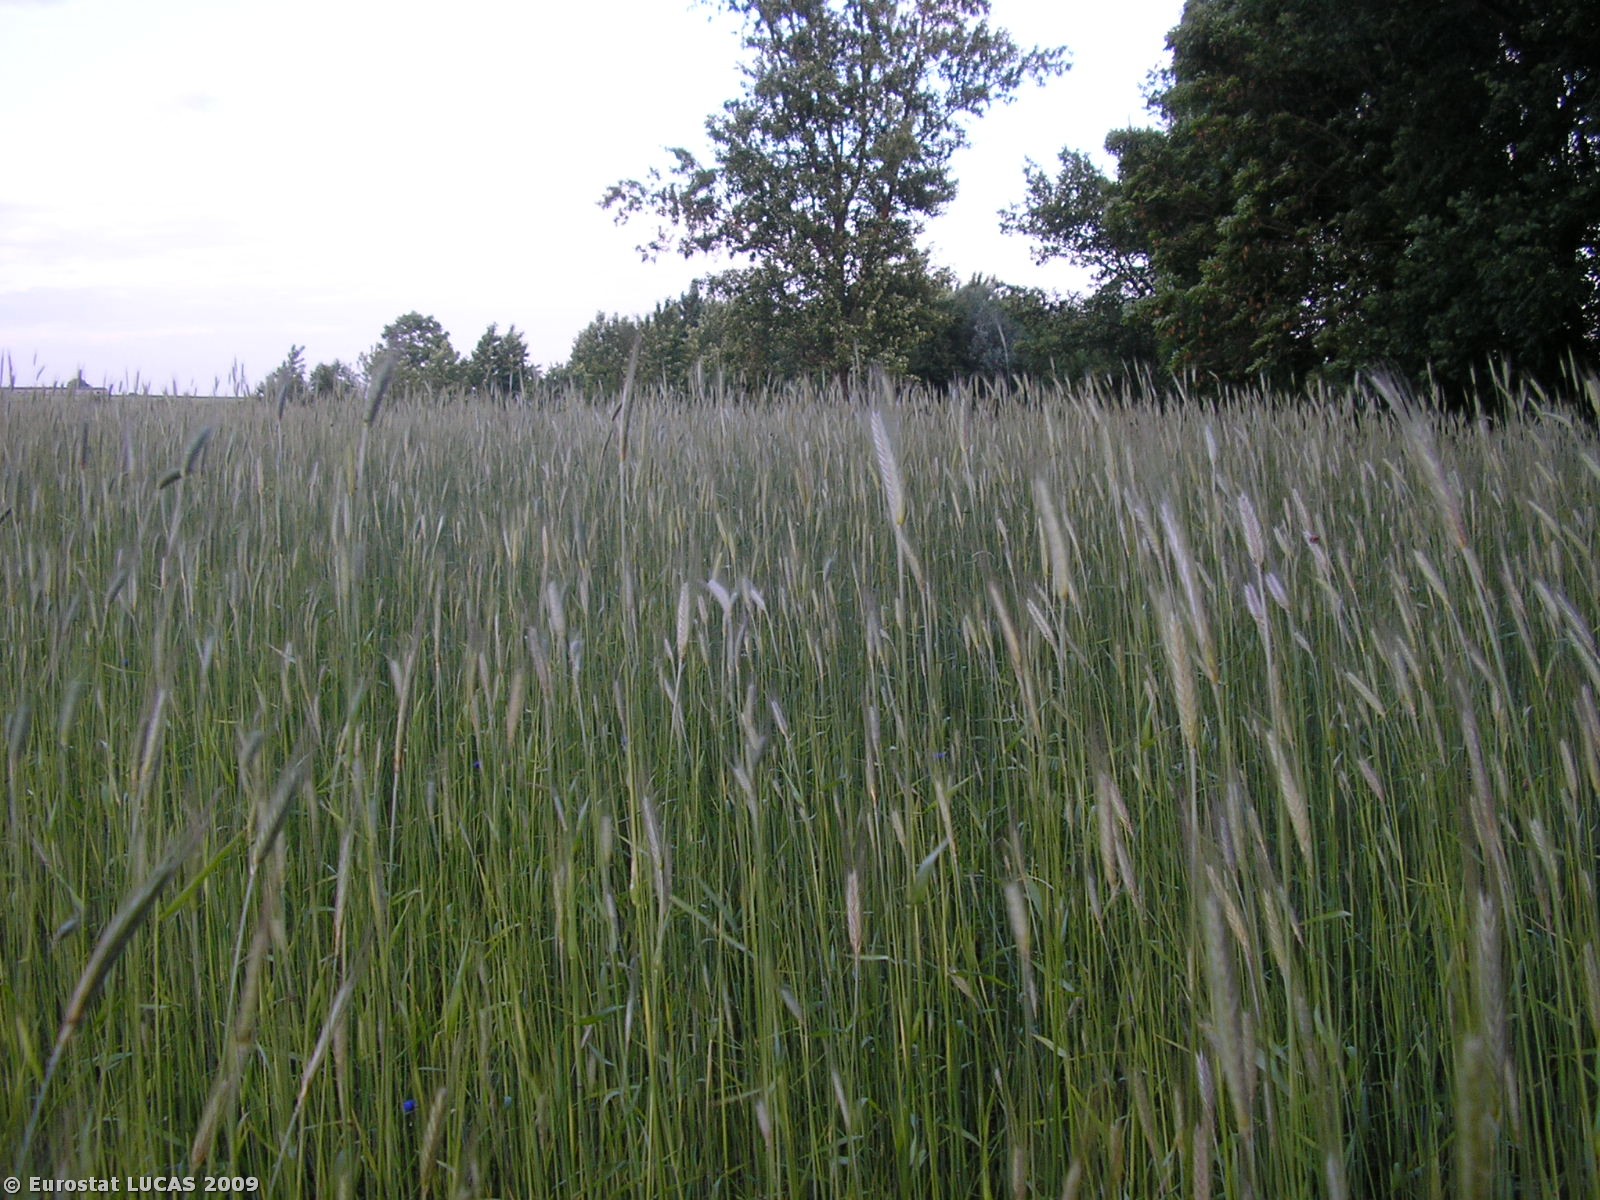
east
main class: Cropland
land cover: Rye
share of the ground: > 75 %
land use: Agriculture (excluding fallow land and kitchen gardens)
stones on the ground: < 10 %
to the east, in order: Rye; Other fibre and oleaginous crops; Grassland with sparse tree/shrub cover; Paved roads, cycling and walking lanes; Broadleaved woodland; Tracks; Shrubland with sparse tree cover; Oats; Triticale
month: June
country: PL
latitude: 51.1450
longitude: 18.3232
